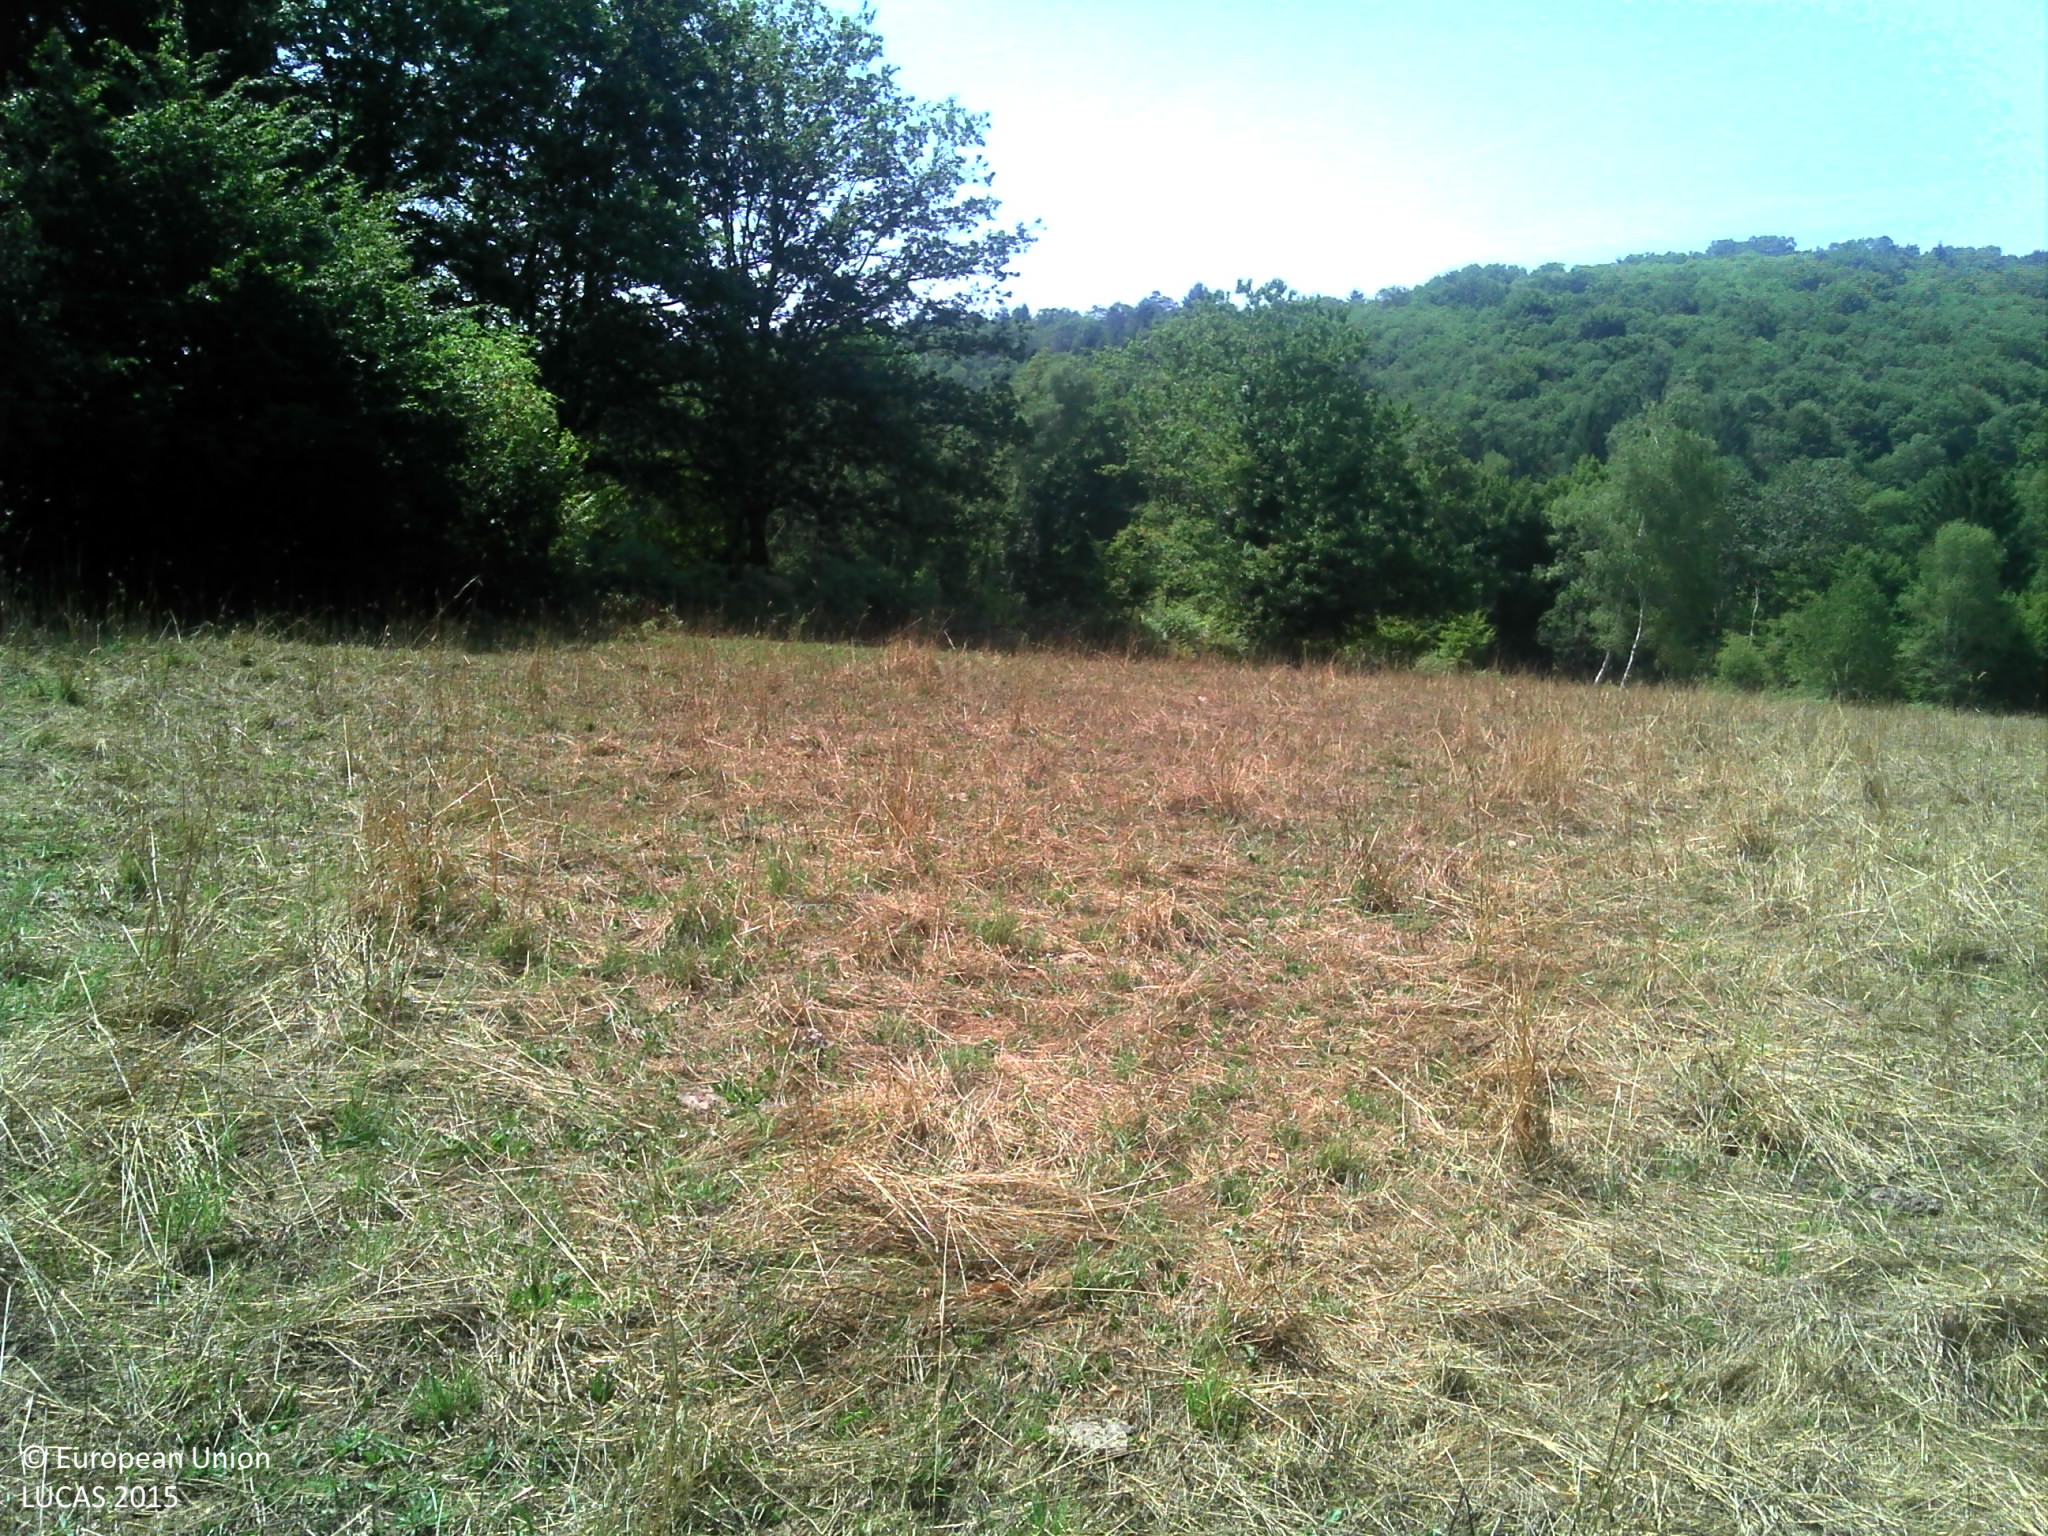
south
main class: Grassland
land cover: Grassland without tree/shrub cover
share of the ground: > 75 %
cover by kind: herbaceous plants 100 %
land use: Agriculture (excluding fallow land and kitchen gardens)
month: August
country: FR
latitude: 45.4188
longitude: 1.7784
